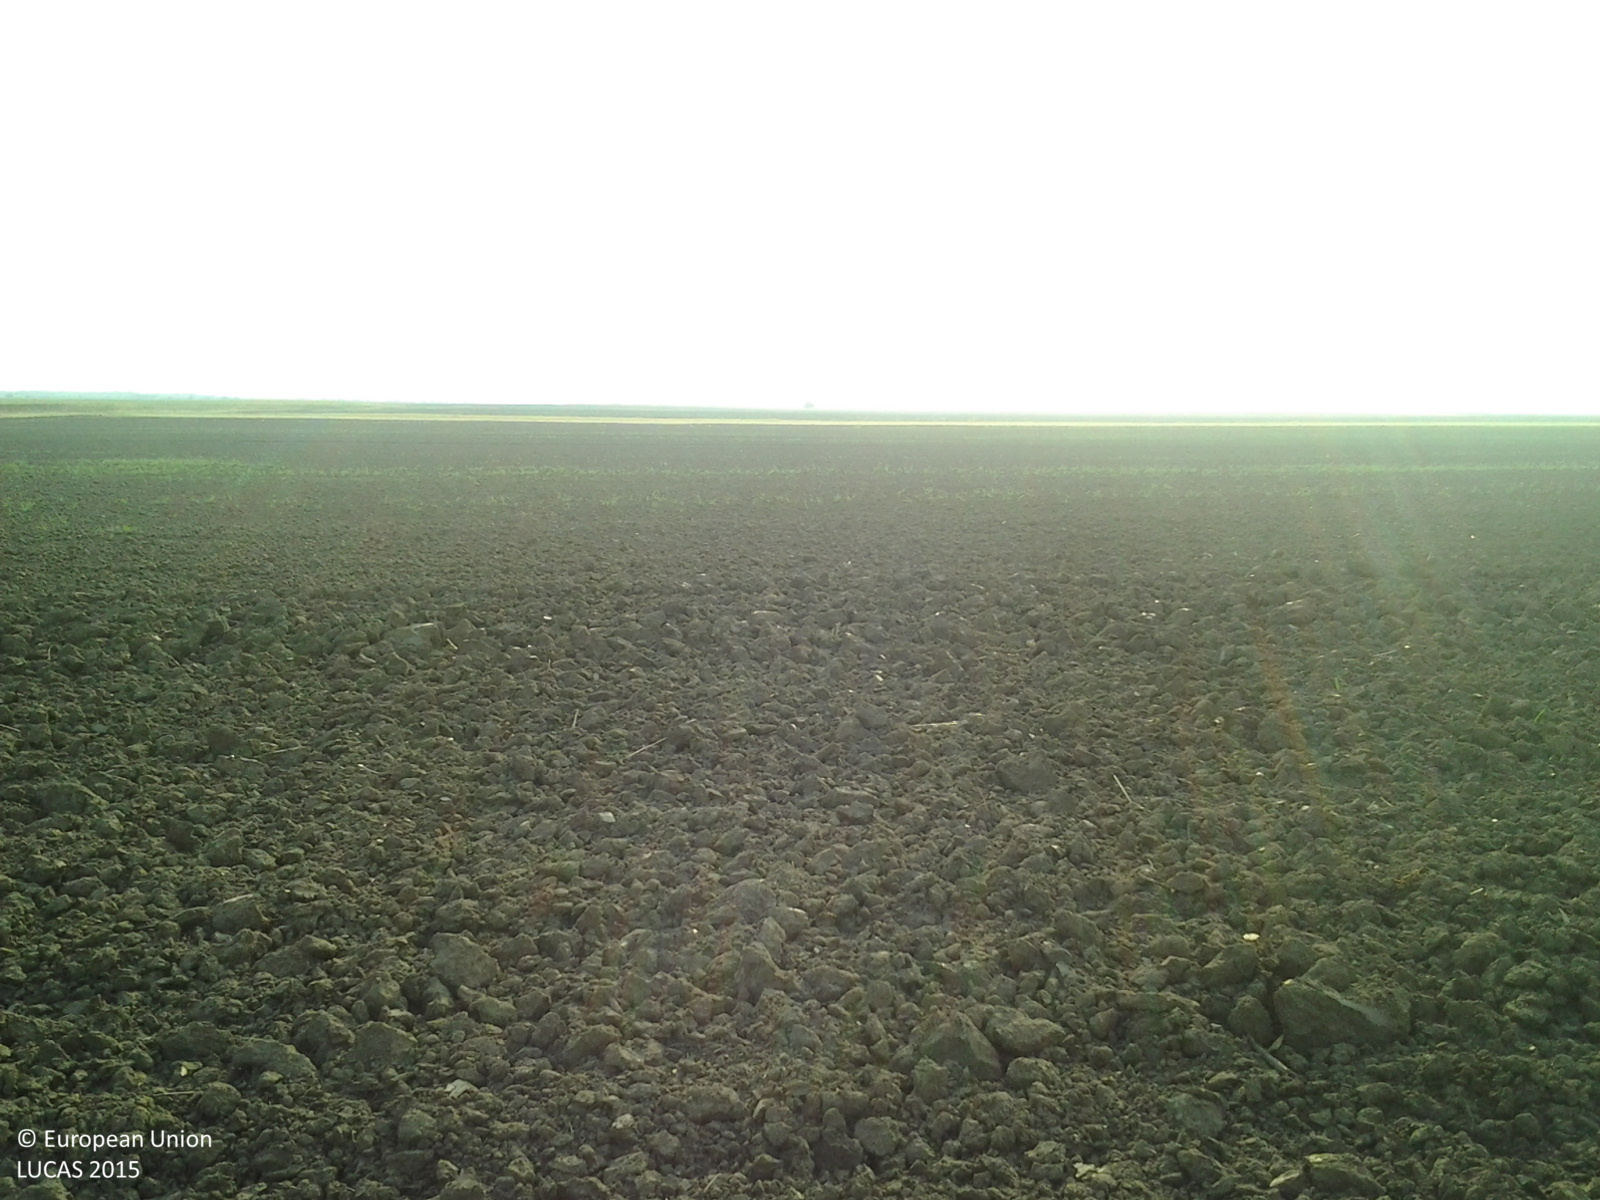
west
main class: Cropland
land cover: Common wheat
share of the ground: < 10 %
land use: Agriculture (excluding fallow land and kitchen gardens)
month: August
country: RO
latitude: 43.9617
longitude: 23.0405
